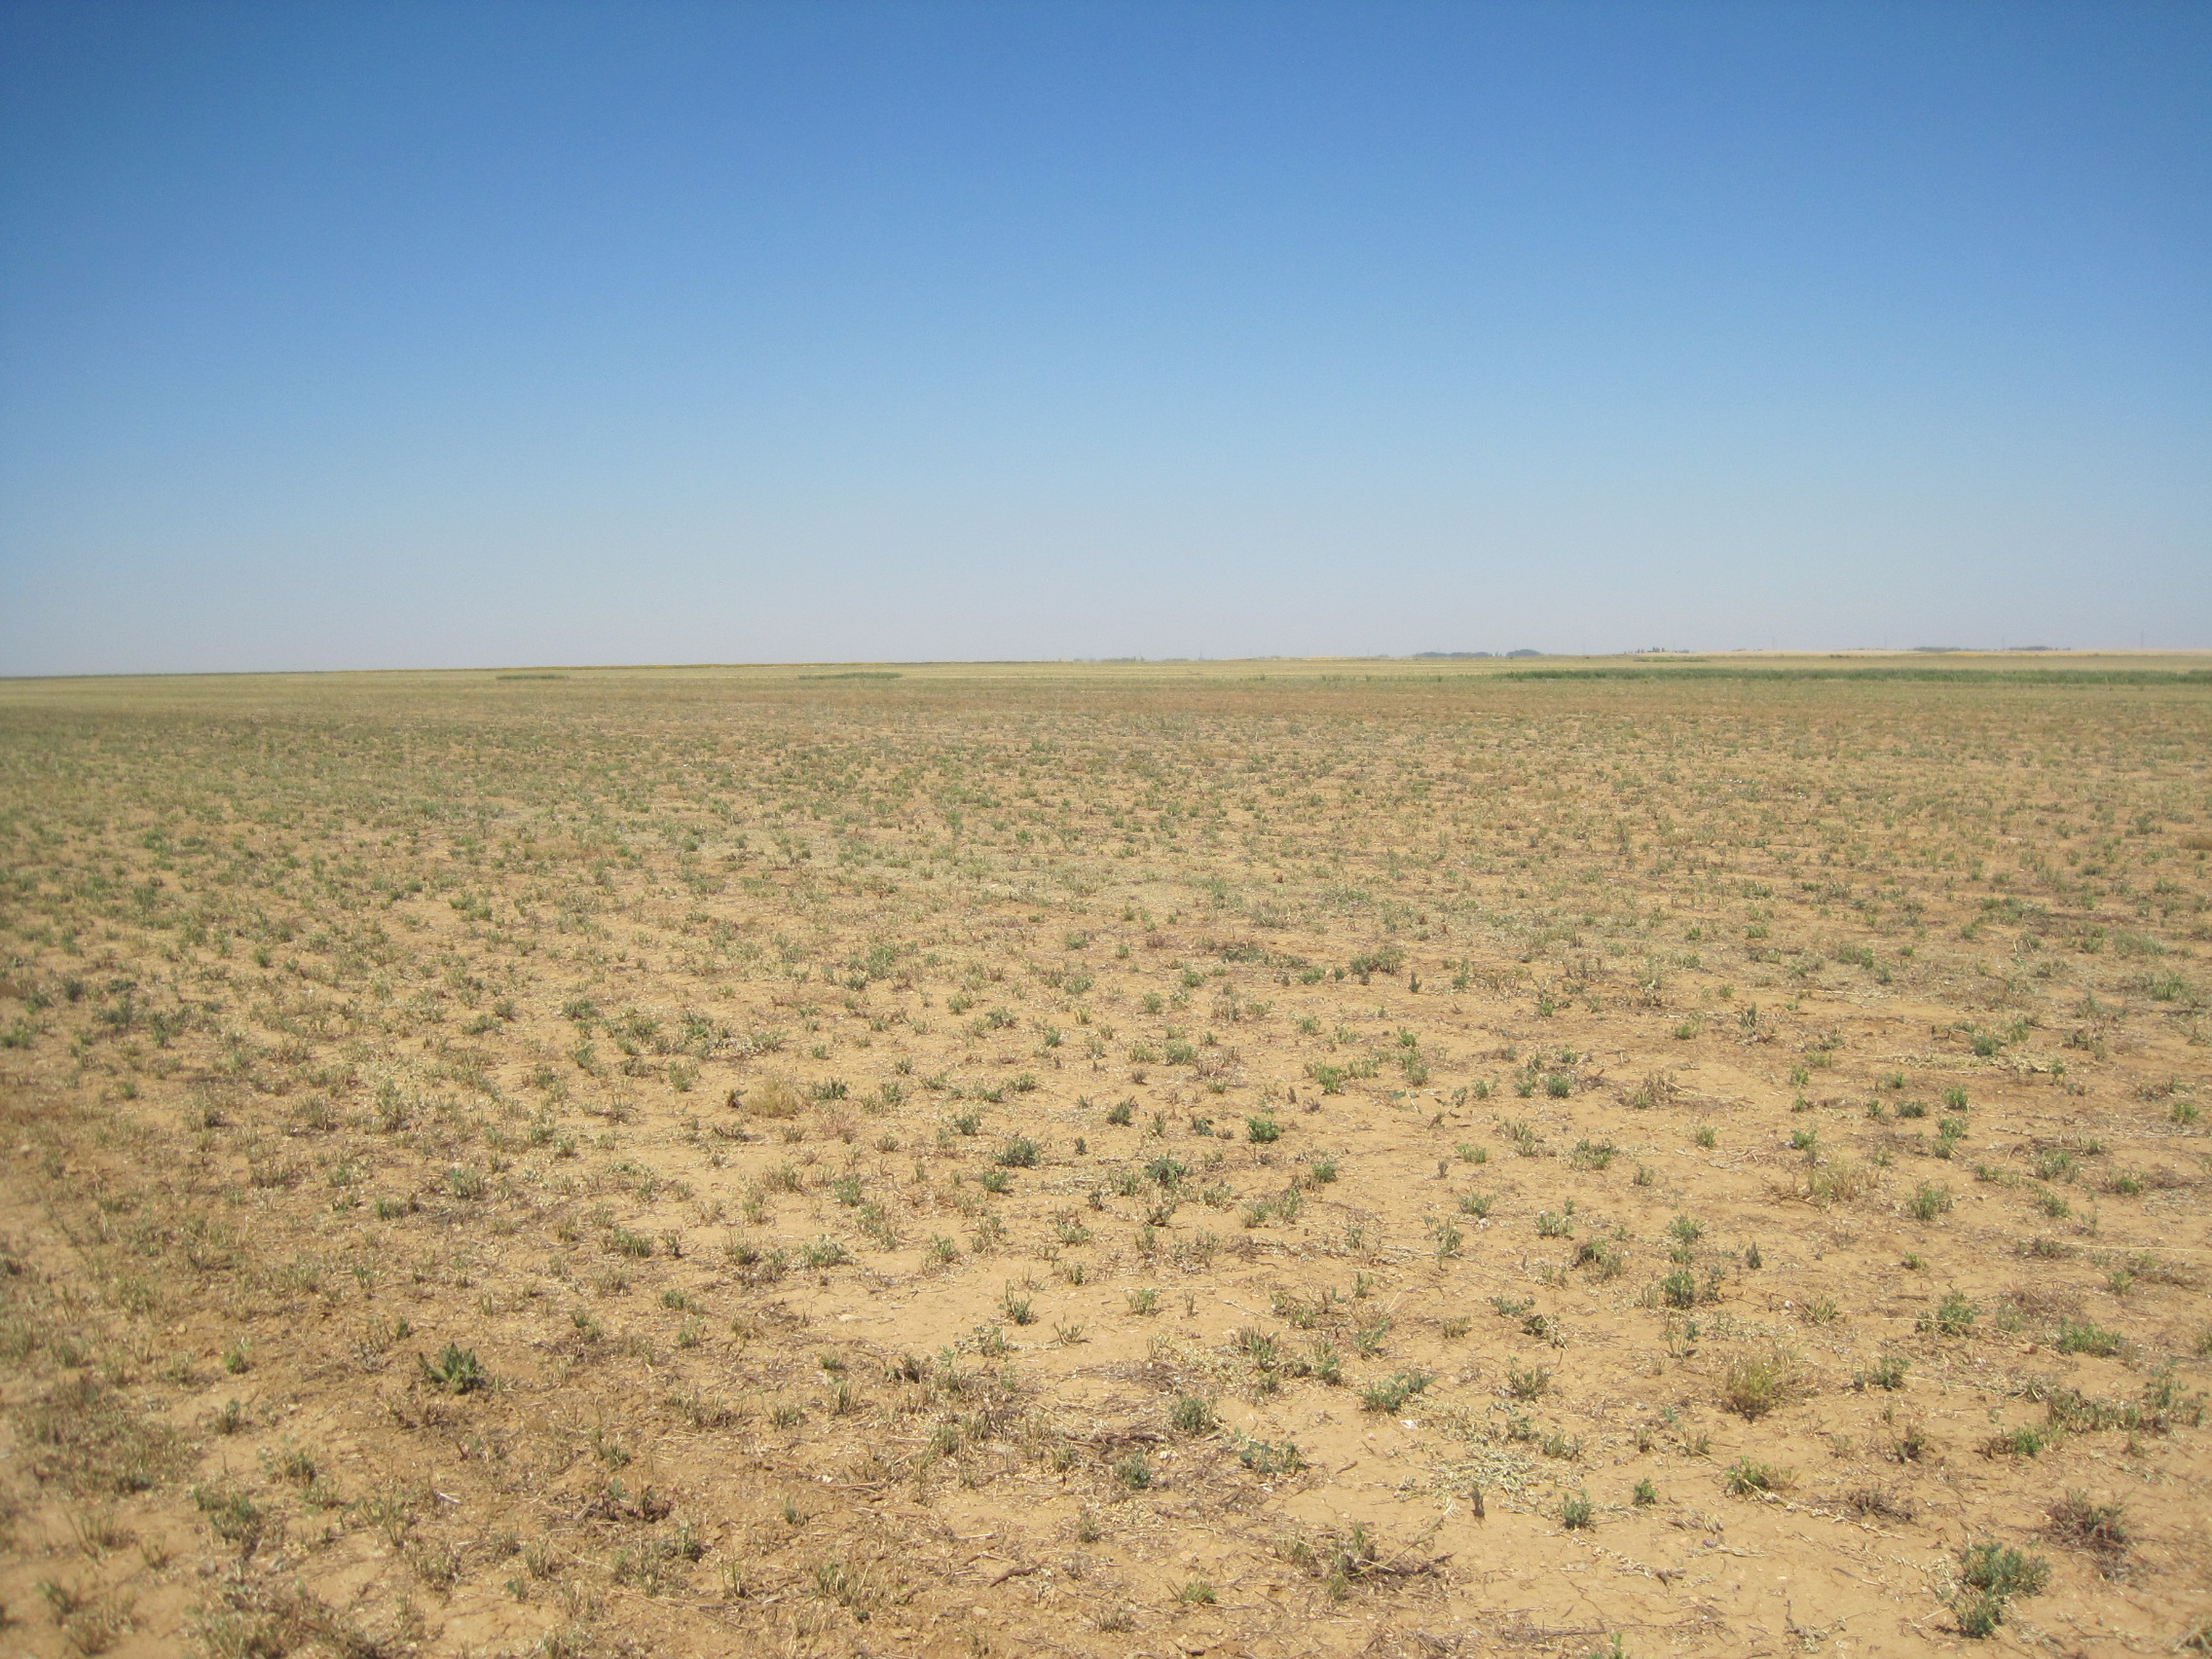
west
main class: Cropland
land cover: Lucerne
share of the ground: 10 - 25 %
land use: Agriculture (excluding fallow land and kitchen gardens)
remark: Harvested field
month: July
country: ES
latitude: 41.9834
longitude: -4.7873
